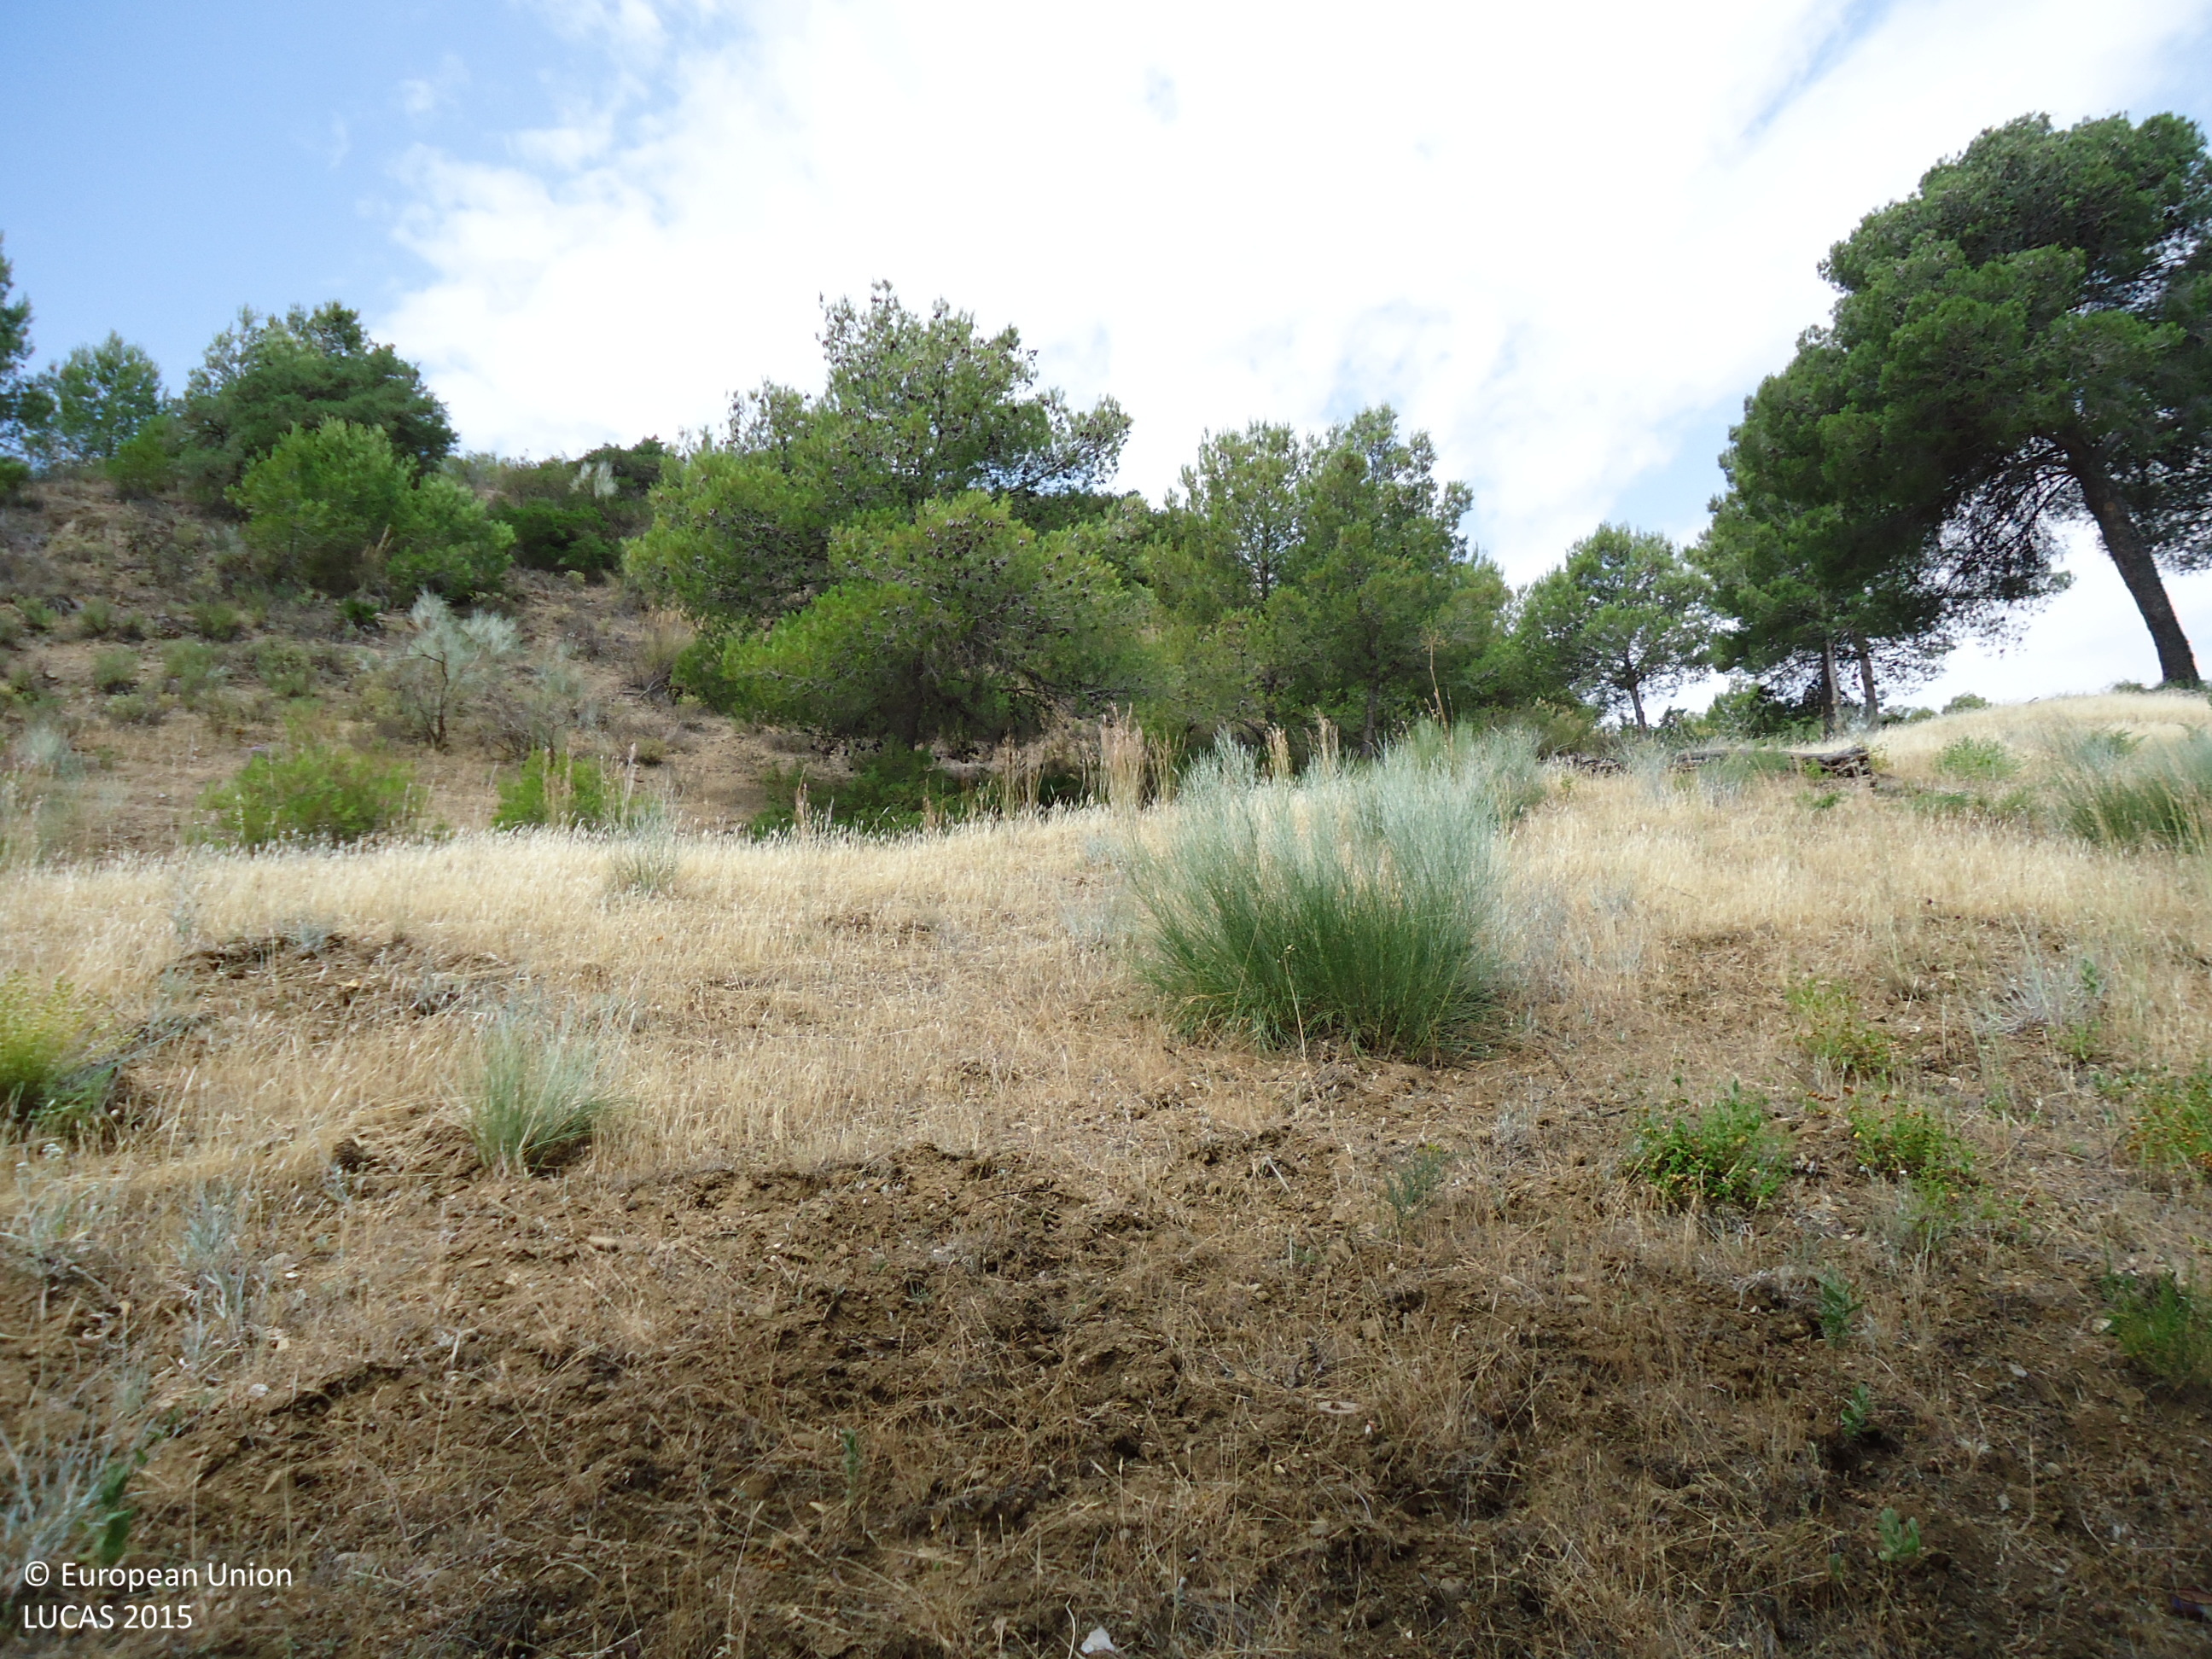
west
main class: Woodland
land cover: Pine dominated coniferous woodland
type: coniferous forest of the mediterranean region
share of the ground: > 75 %
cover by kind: coniferous forest trees 75 %, consolidated bare surface 20 %, shrubs 5 %
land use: Forestry
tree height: > 5 m
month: June
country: ES
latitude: 36.9134
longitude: -4.8026
